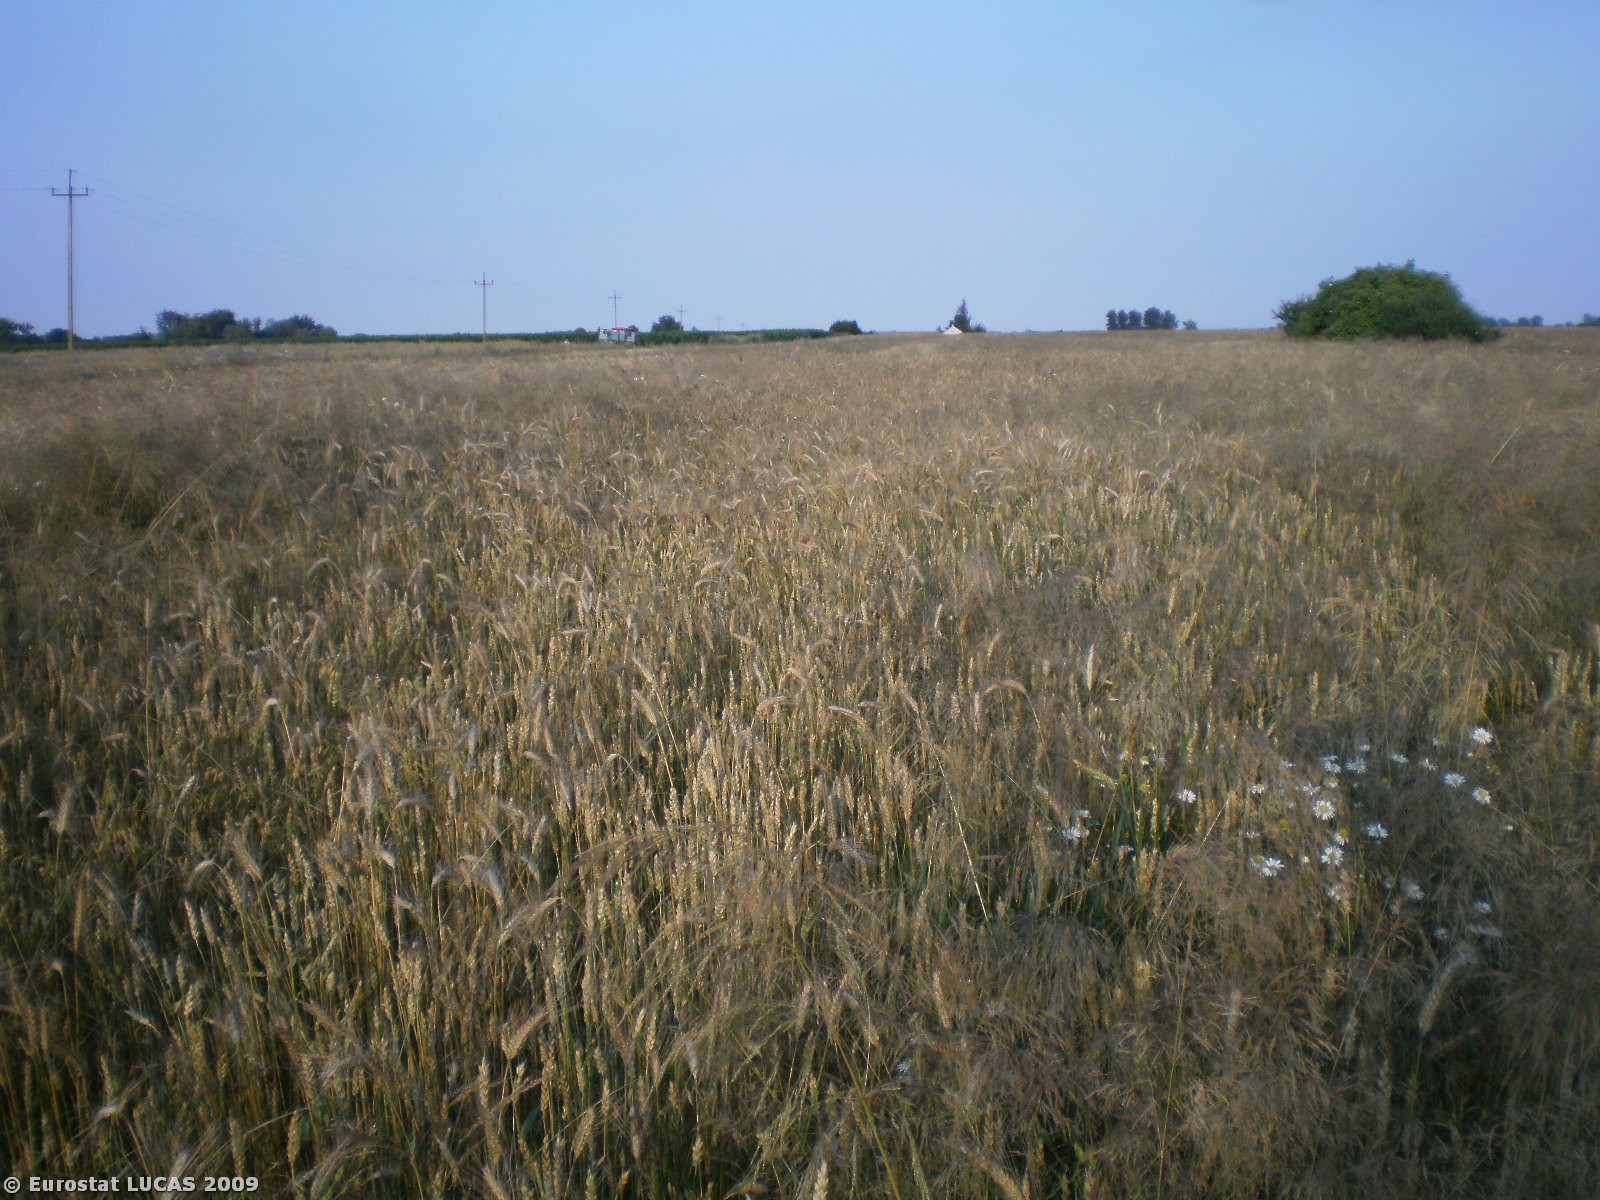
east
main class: Cropland
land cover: Common wheat
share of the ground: > 75 %
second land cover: Triticale
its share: < 10 %
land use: Agriculture (excluding fallow land and kitchen gardens)
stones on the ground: < 10 %
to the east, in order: Common wheat; Triticale; Tracks; Maize
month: July
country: PL
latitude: 52.8744
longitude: 20.8734
